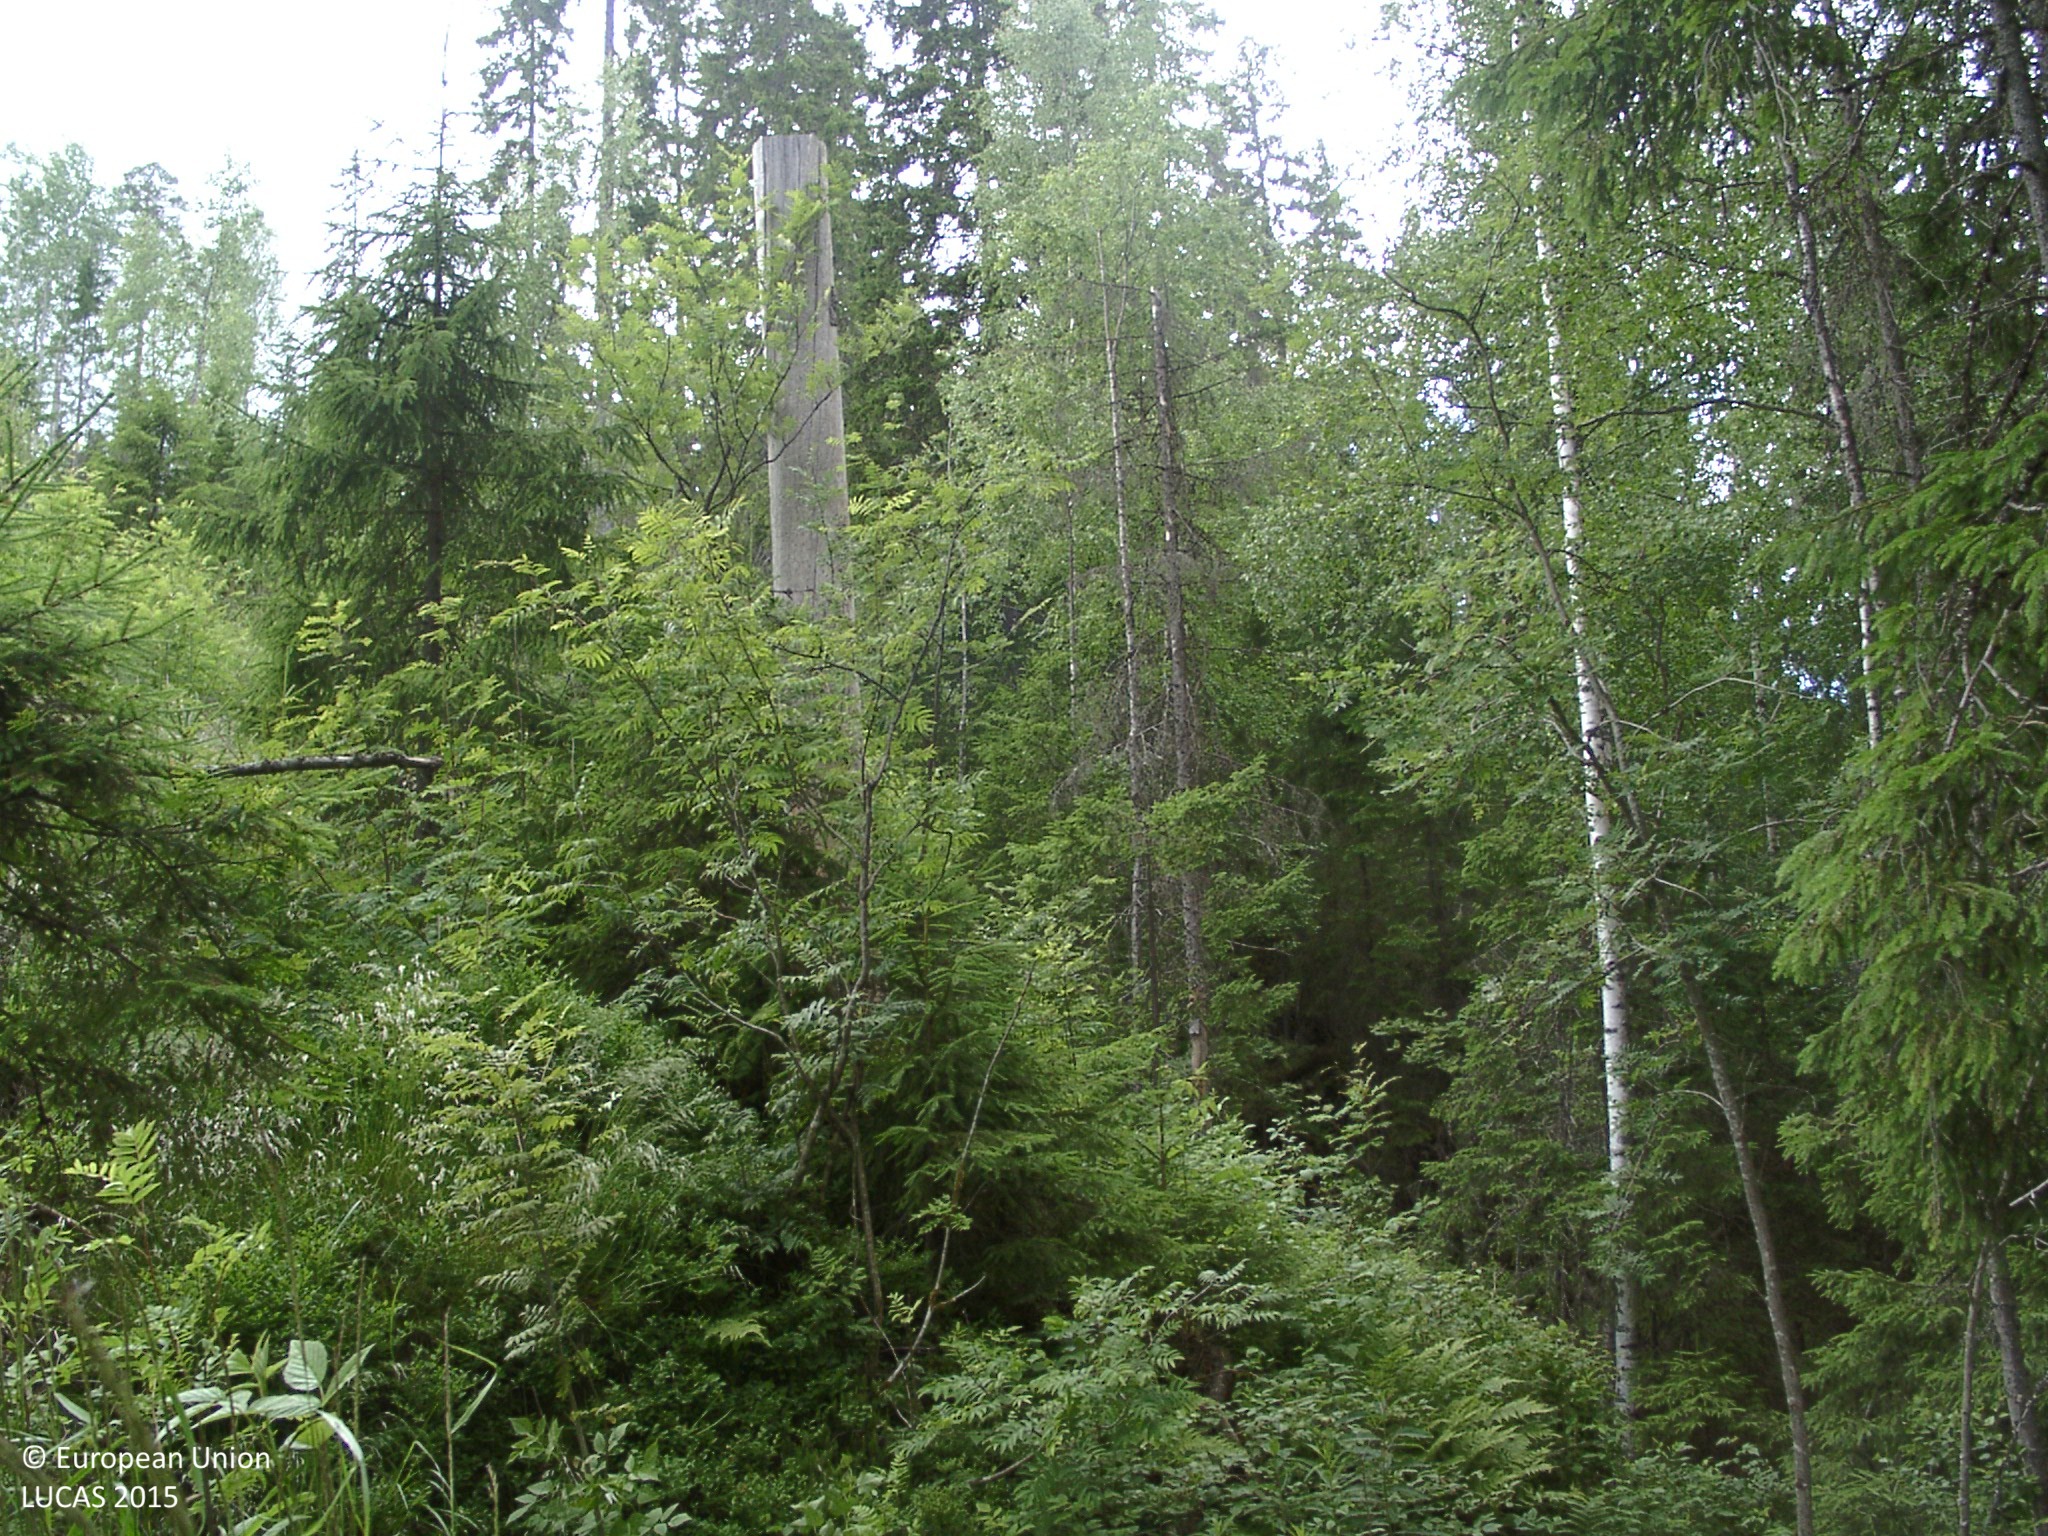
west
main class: Woodland
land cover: Spruce dominated mixed woodland
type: boreal forest
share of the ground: > 75 %
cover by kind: coniferous forest trees 40 %, broadleaved forest trees 35 %, shrubs 15 %, herbaceous plants 10 %
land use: Forestry
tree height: > 5 m
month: July
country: FI
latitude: 61.6501
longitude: 25.1959
